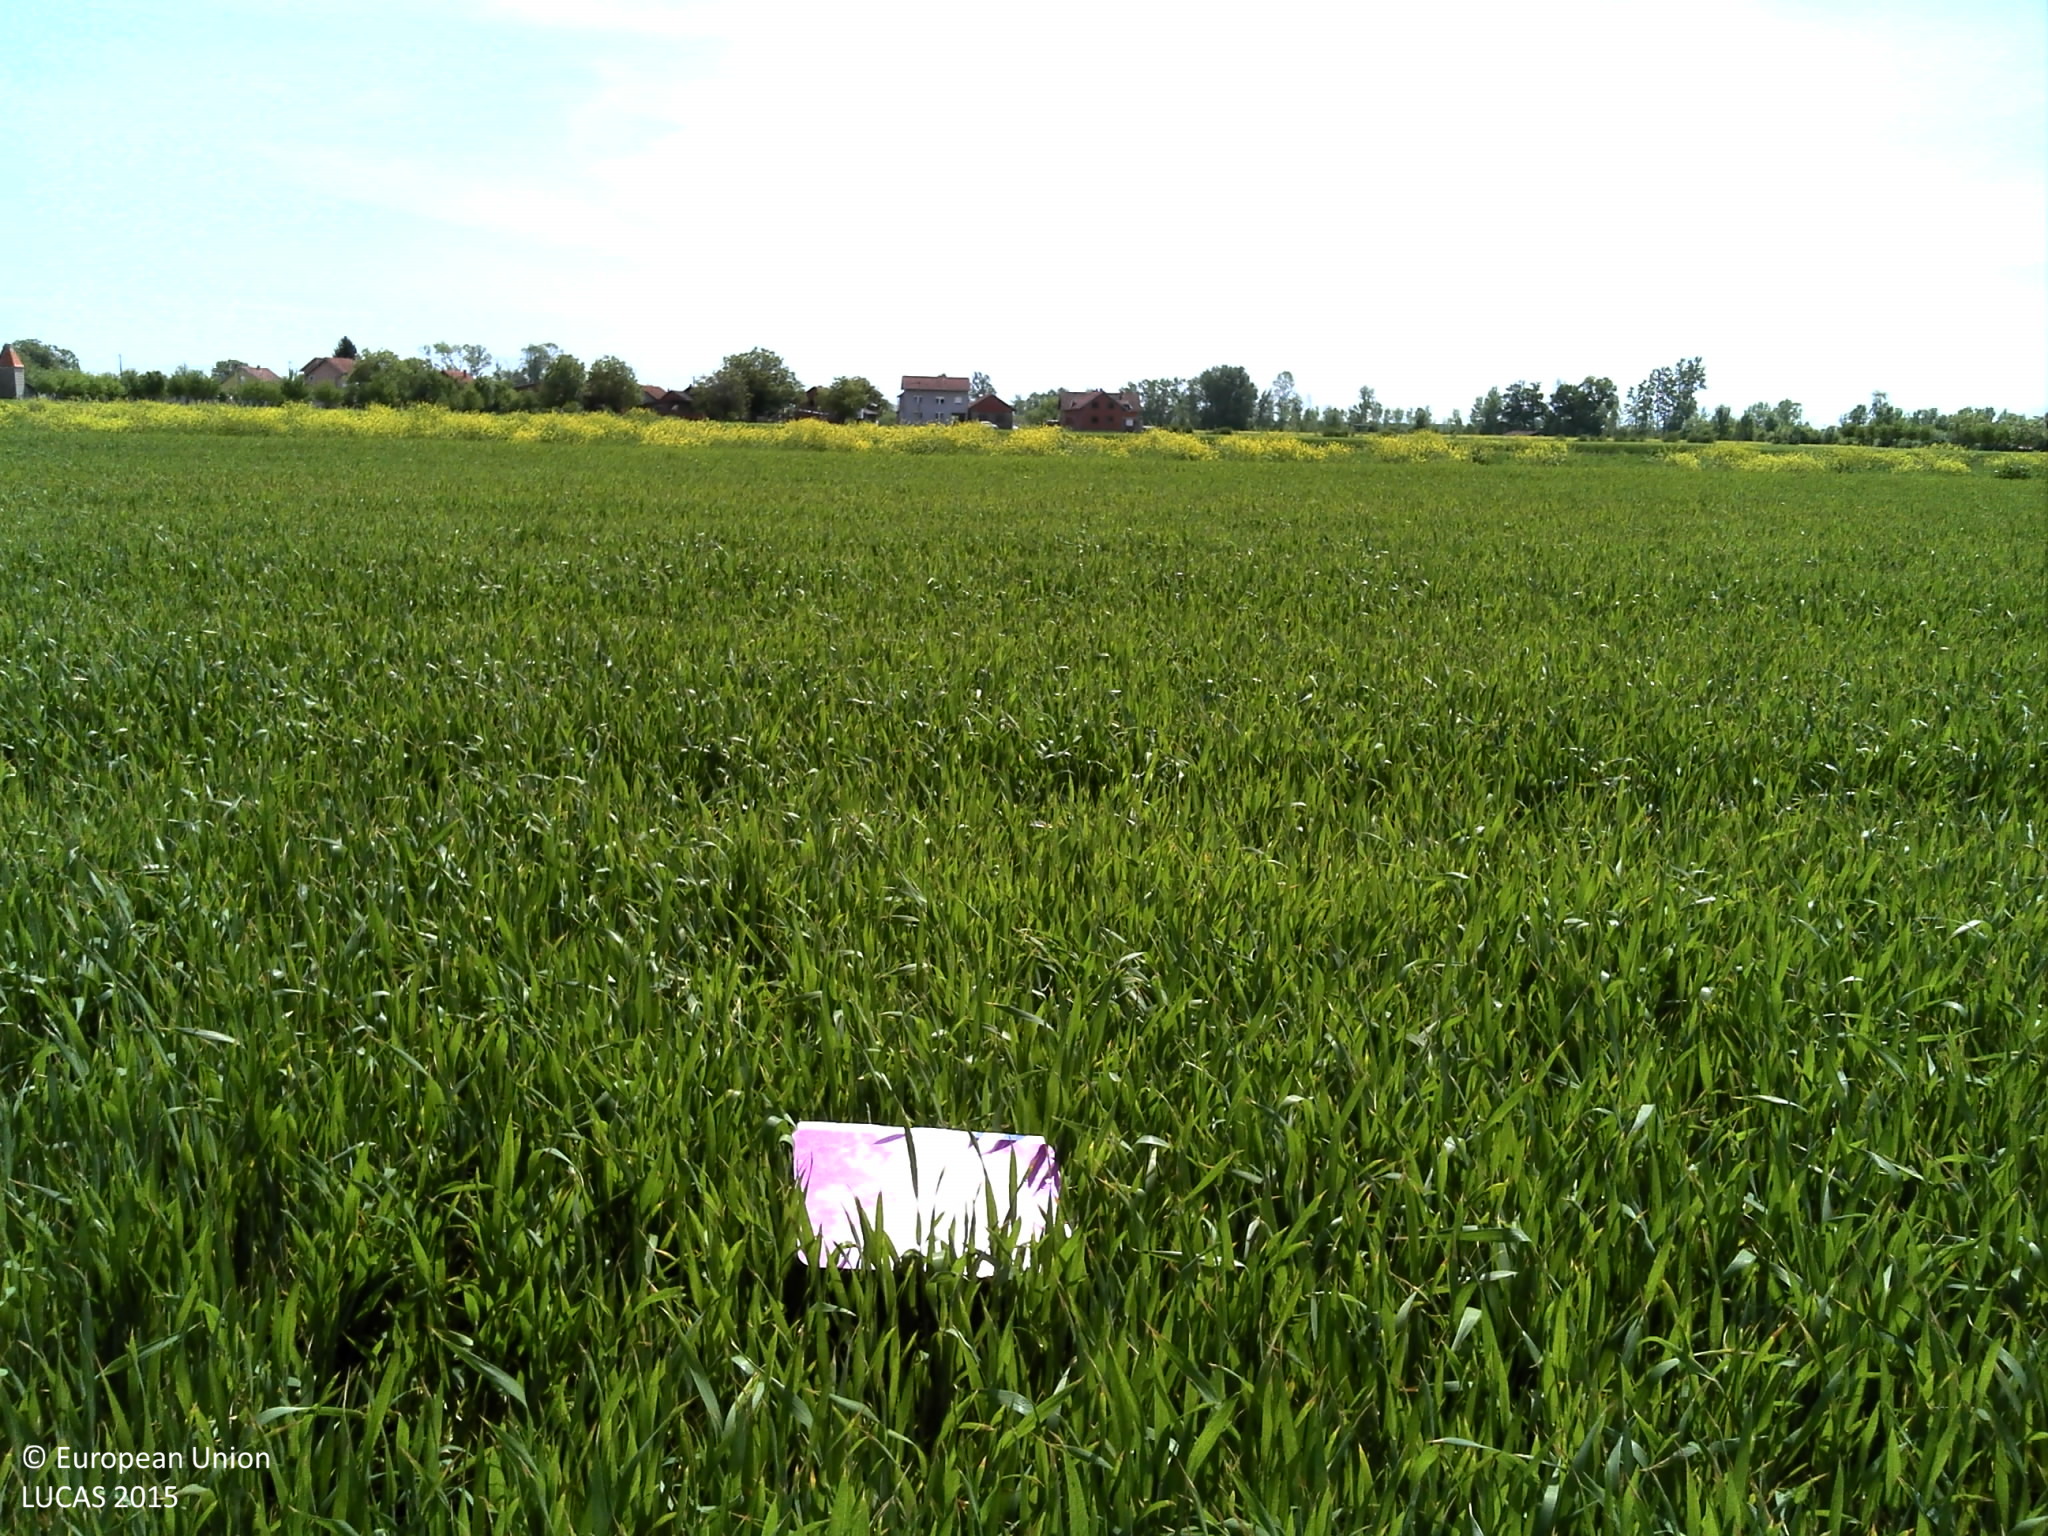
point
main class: Cropland
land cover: Common wheat
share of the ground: > 75 %
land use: Agriculture (excluding fallow land and kitchen gardens)
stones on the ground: < 10 %
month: May
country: HR
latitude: 45.2378
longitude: 18.8864
